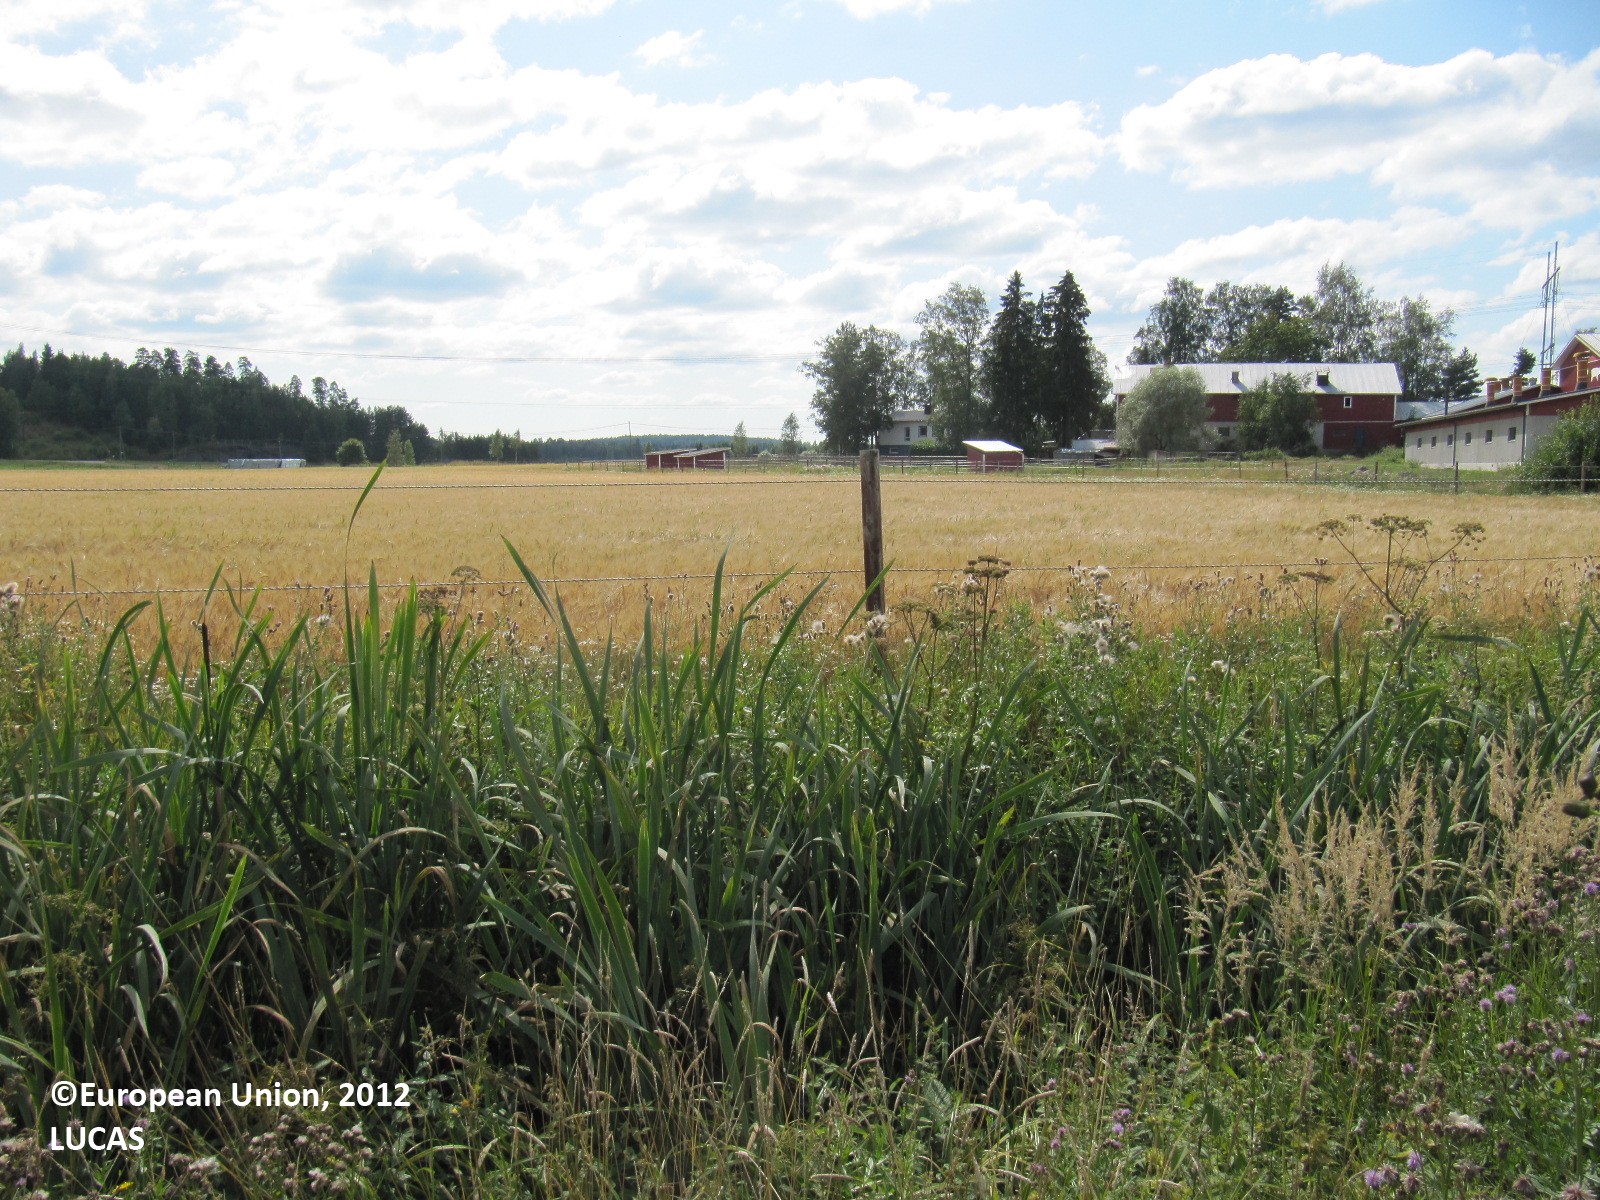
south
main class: Cropland
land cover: Common wheat
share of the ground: > 75 %
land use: Agriculture (excluding fallow land and kitchen gardens)
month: August
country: FI
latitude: 60.4687
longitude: 24.5303
